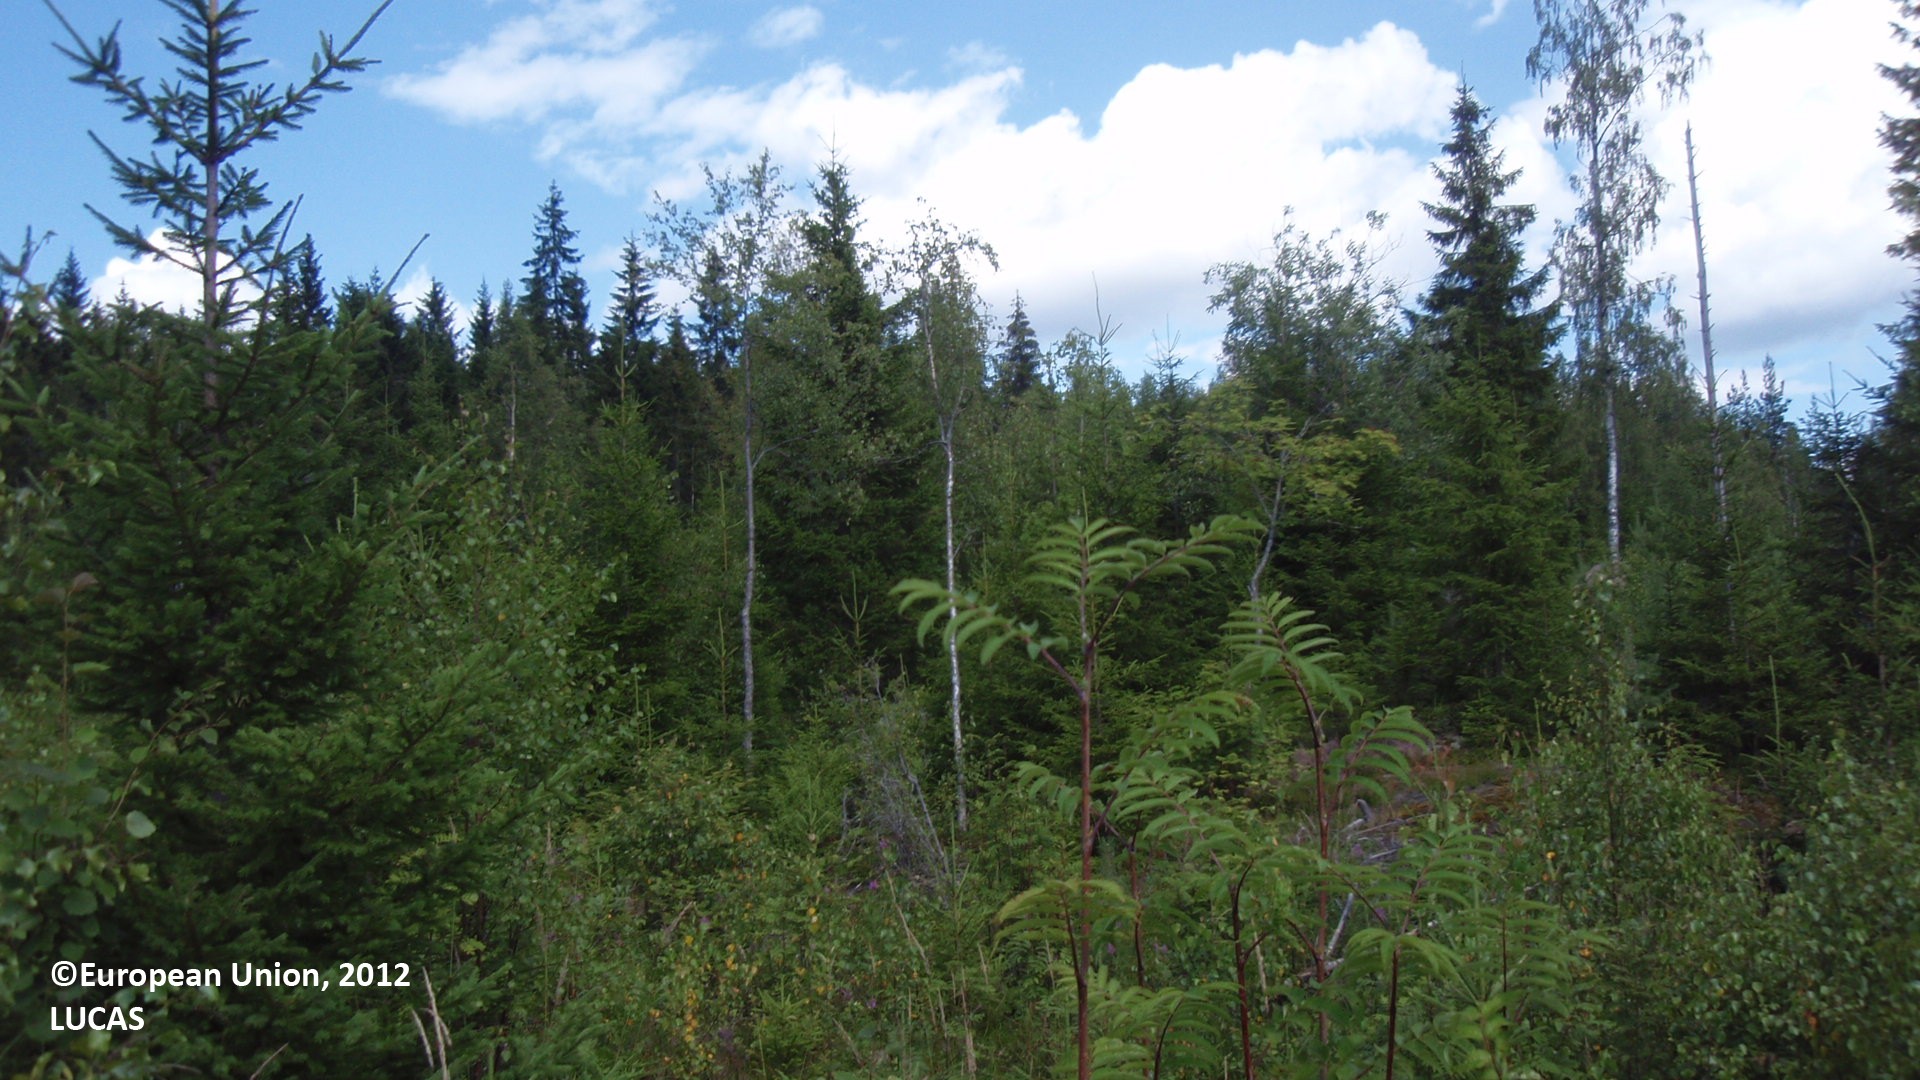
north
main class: Shrubland
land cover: Shrubland with sparse tree cover
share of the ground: > 75 %
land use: Forestry
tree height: < 5 m
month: July
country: FI
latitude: 61.4313
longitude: 28.9174
